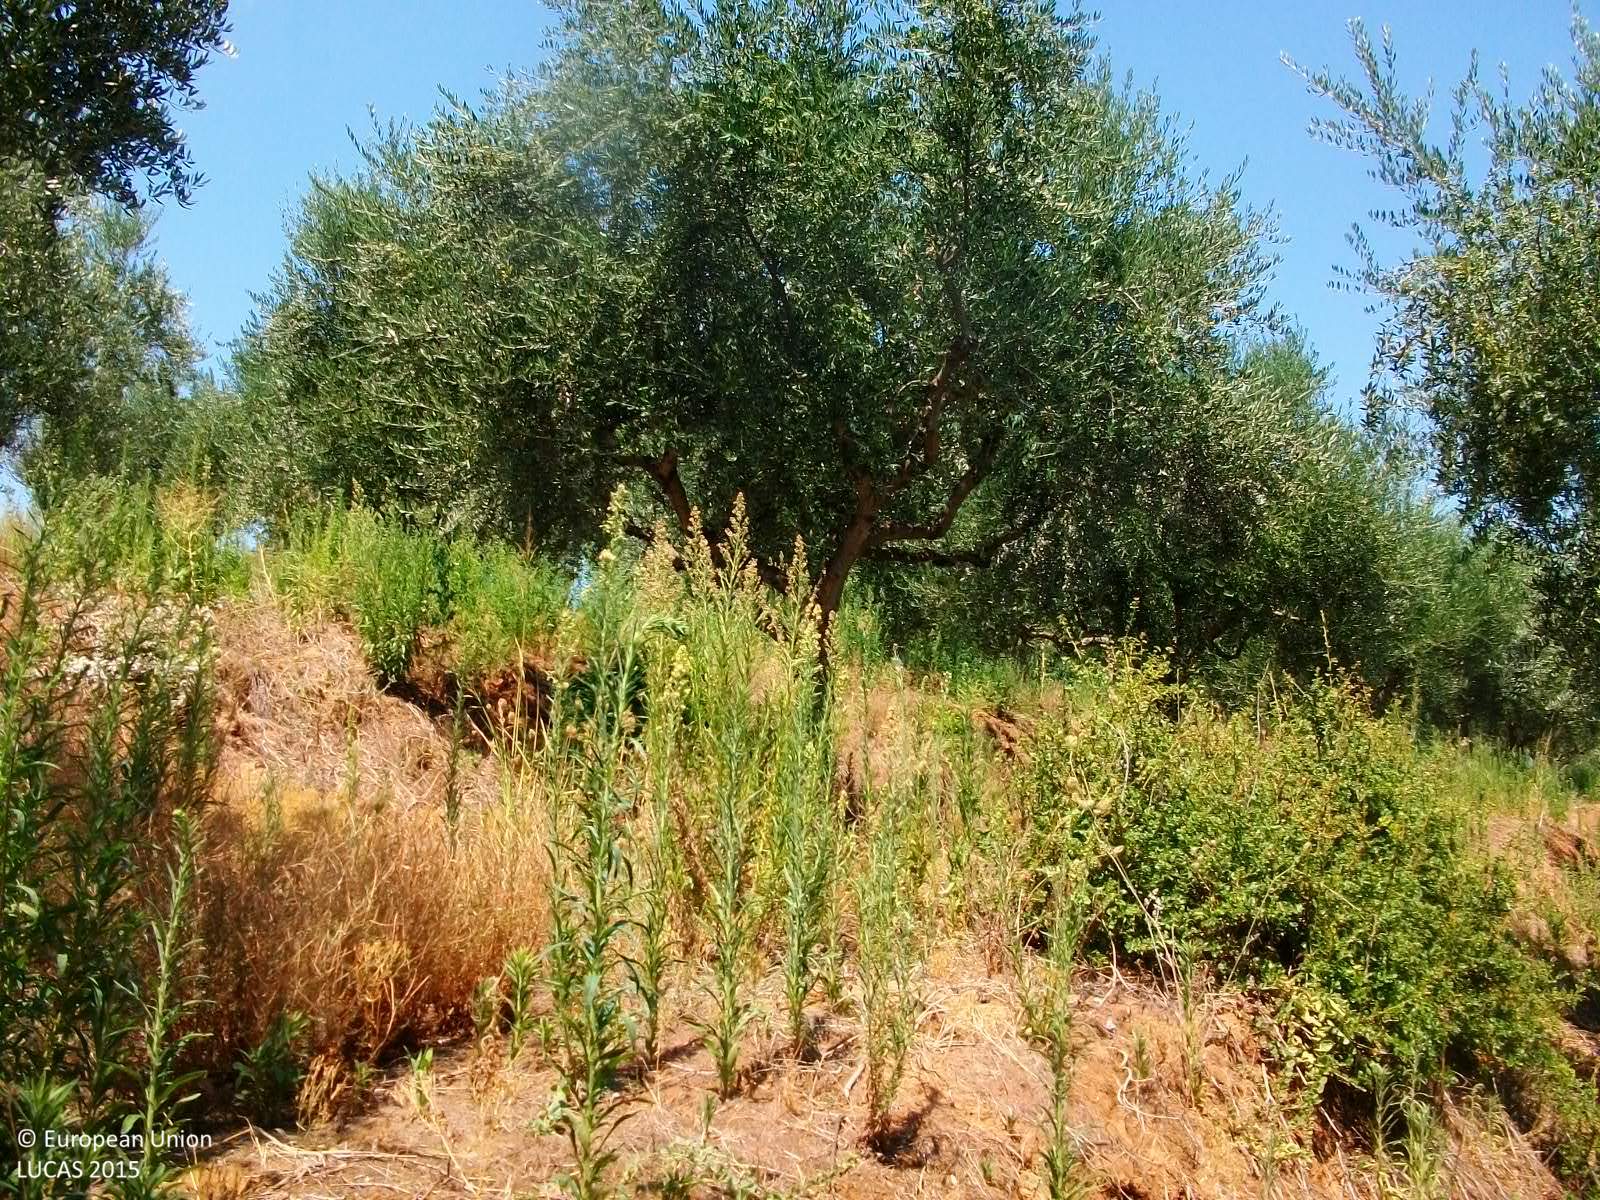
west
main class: Cropland
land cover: Olive groves
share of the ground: > 75 %
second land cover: Spontaneously vegetated surfaces
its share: > 75 %
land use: Agriculture (excluding fallow land and kitchen gardens)
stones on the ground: < 10 %
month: August
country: GR
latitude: 37.1083
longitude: 21.8928
